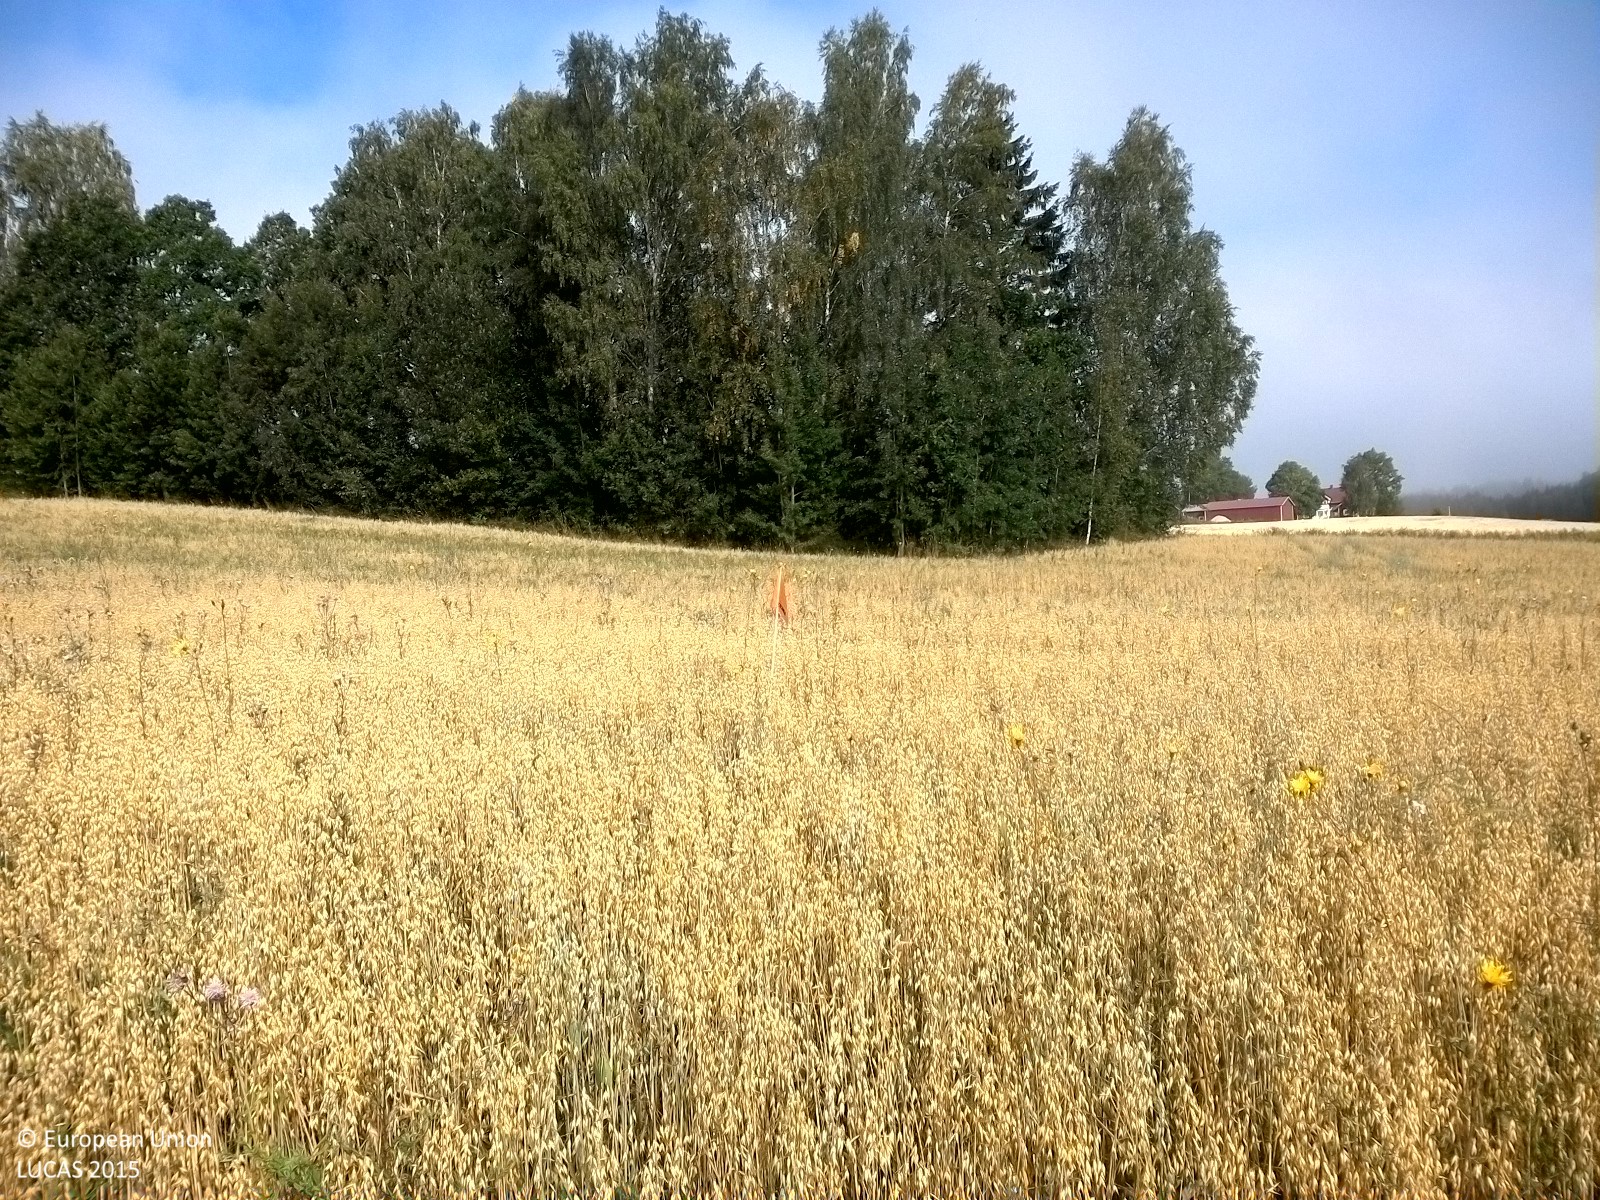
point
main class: Cropland
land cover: Oats
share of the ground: > 75 %
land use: Agriculture (excluding fallow land and kitchen gardens)
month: August
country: SE
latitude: 59.3819
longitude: 15.1841
